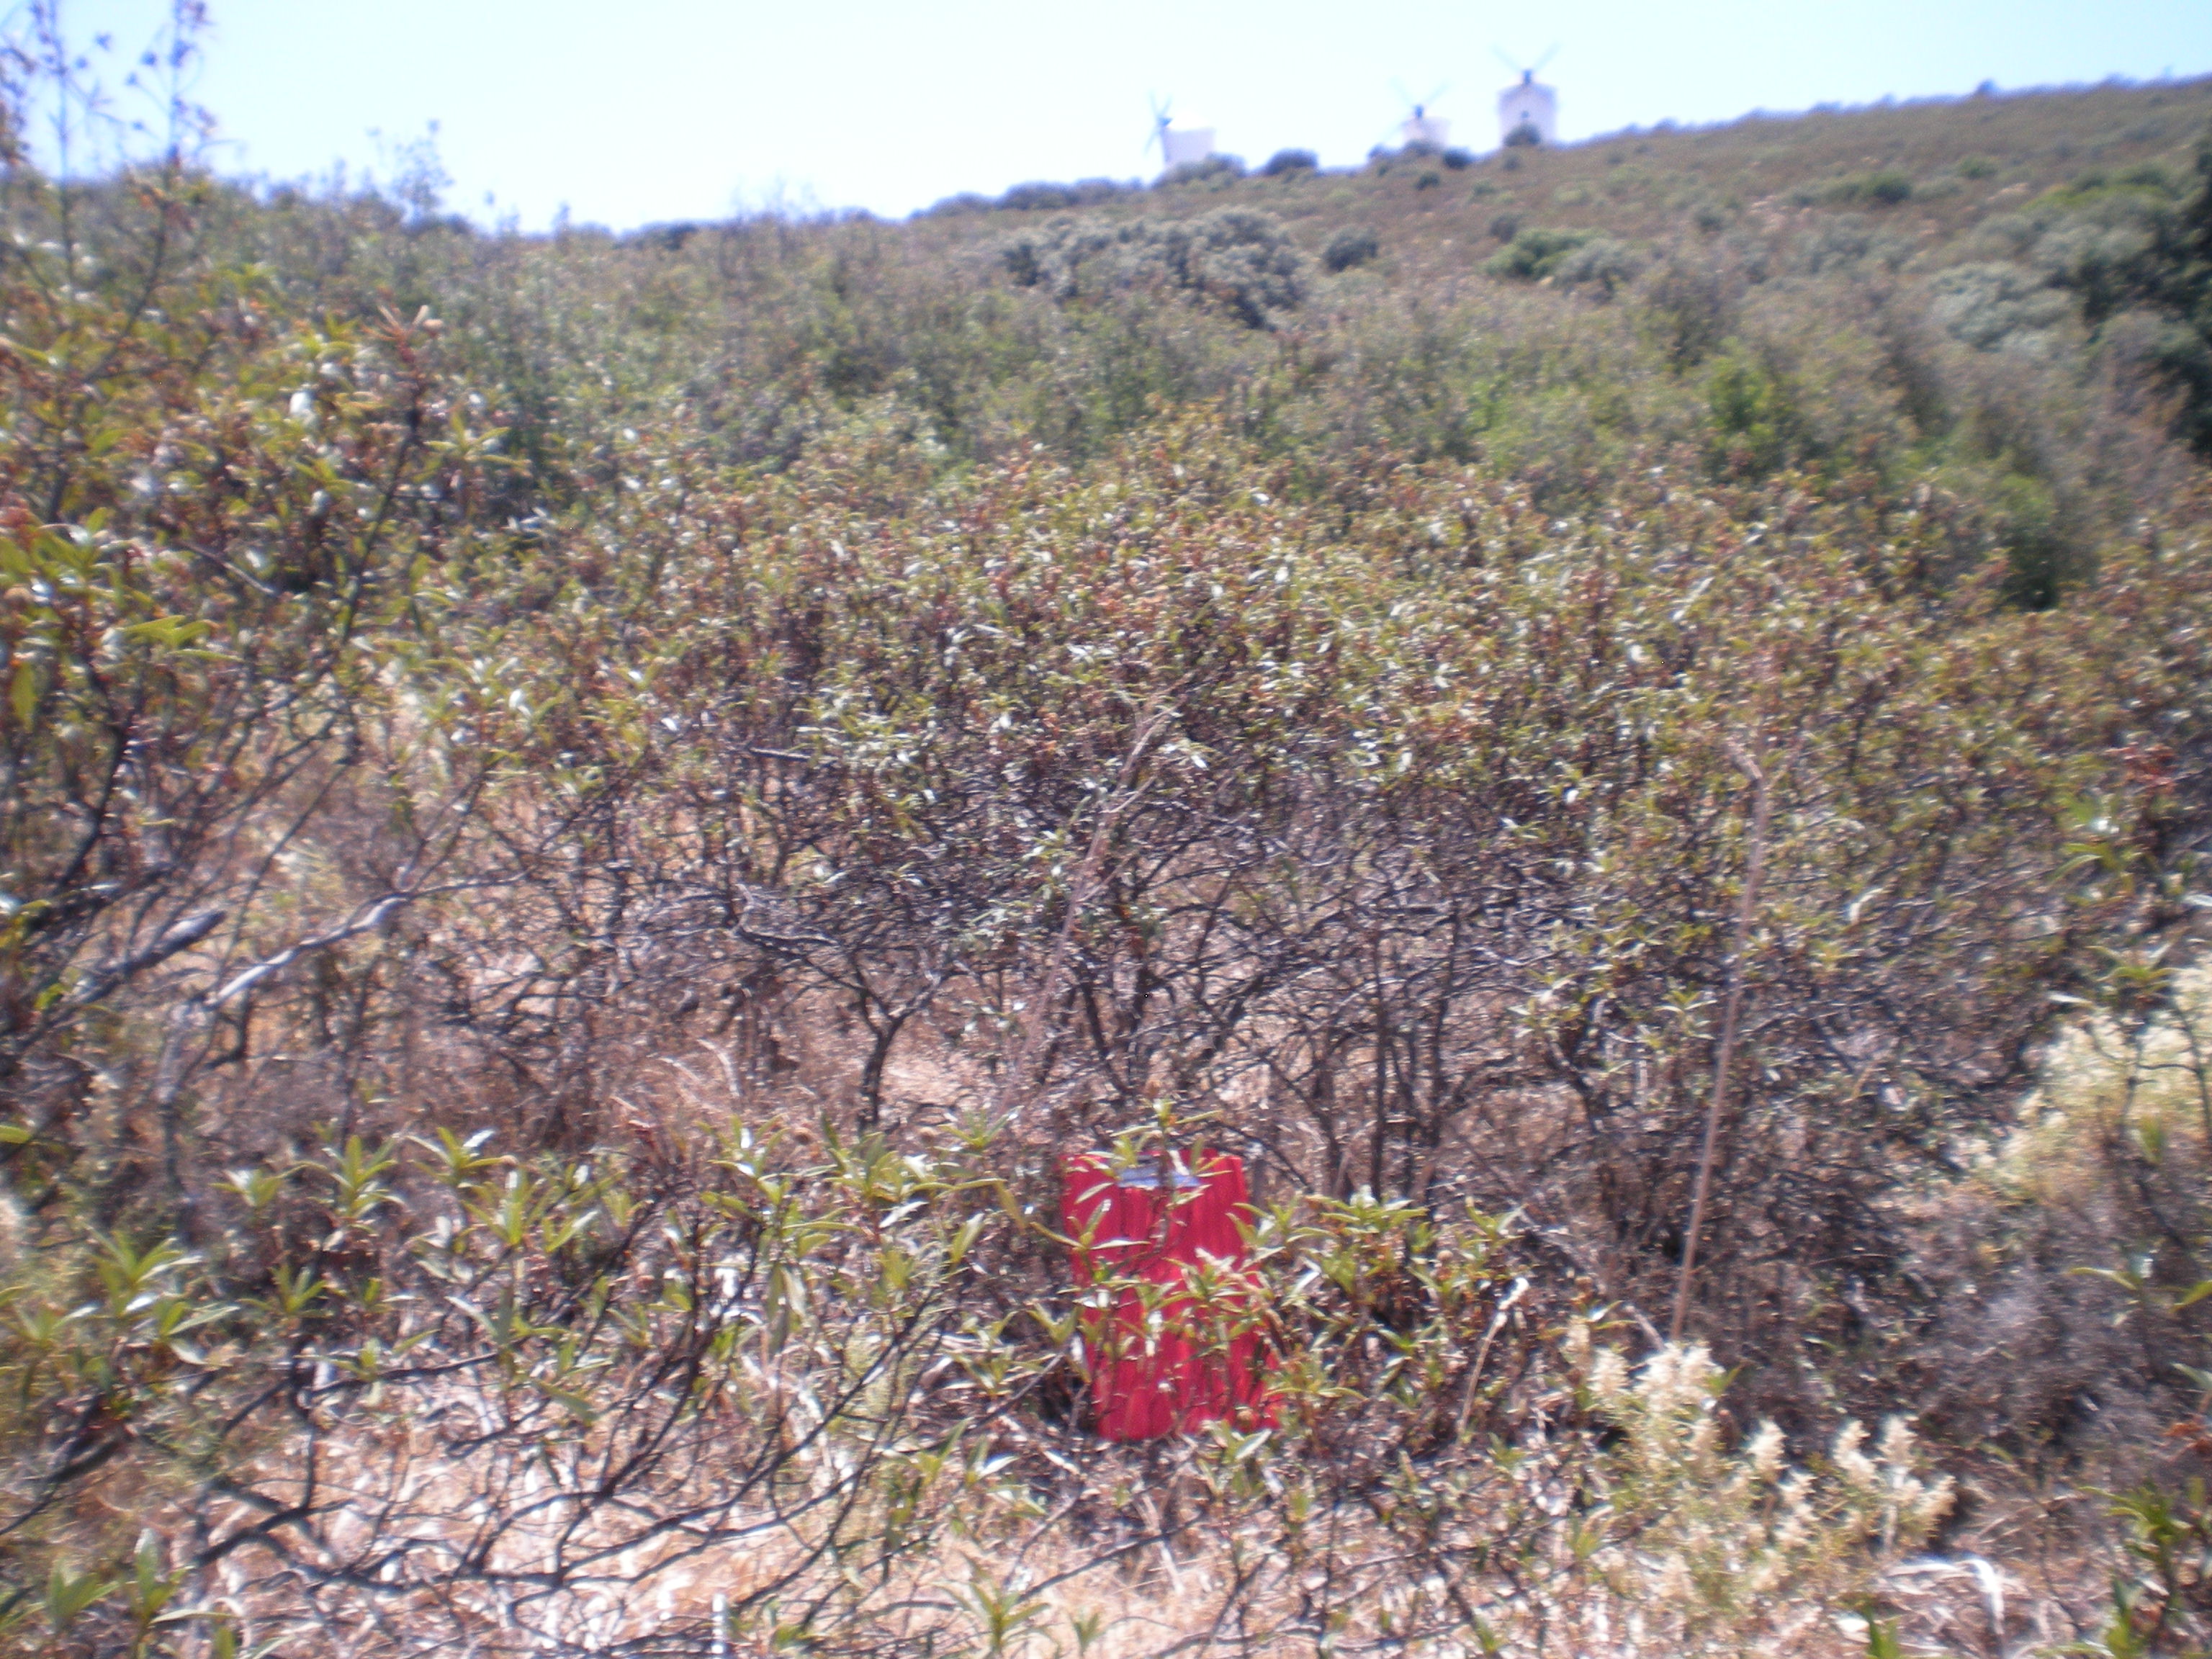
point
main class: Shrubland
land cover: Shrubland with sparse tree cover
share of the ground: > 75 %
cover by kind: shrubs 75 %, herbaceous plants 10 %, unconsolidated bare surface 10 %, broadleaved forest trees 5 %
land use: Semi-natural and natural areas not in use
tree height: < 5 m
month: July
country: ES
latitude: 39.3311
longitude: -3.4889
